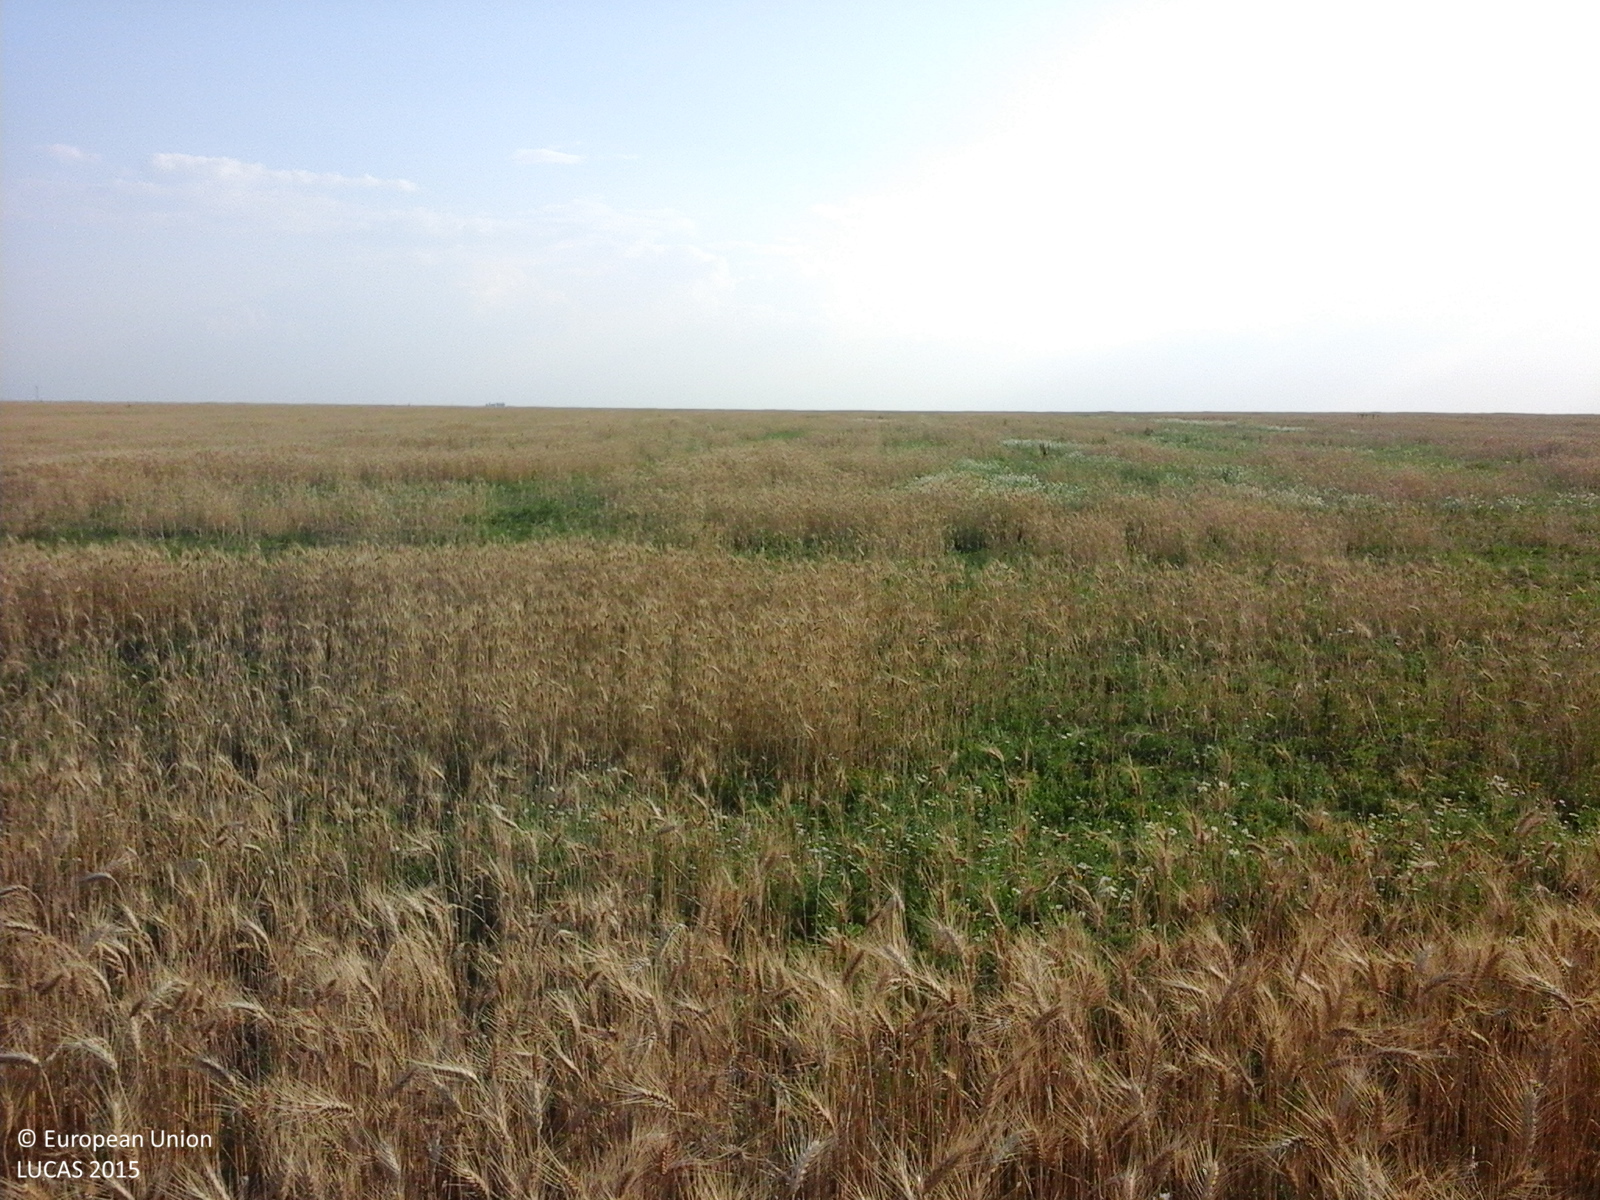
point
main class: Cropland
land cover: Common wheat
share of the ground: > 75 %
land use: Agriculture (excluding fallow land and kitchen gardens)
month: July
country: RO
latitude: 44.1623
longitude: 24.9197
